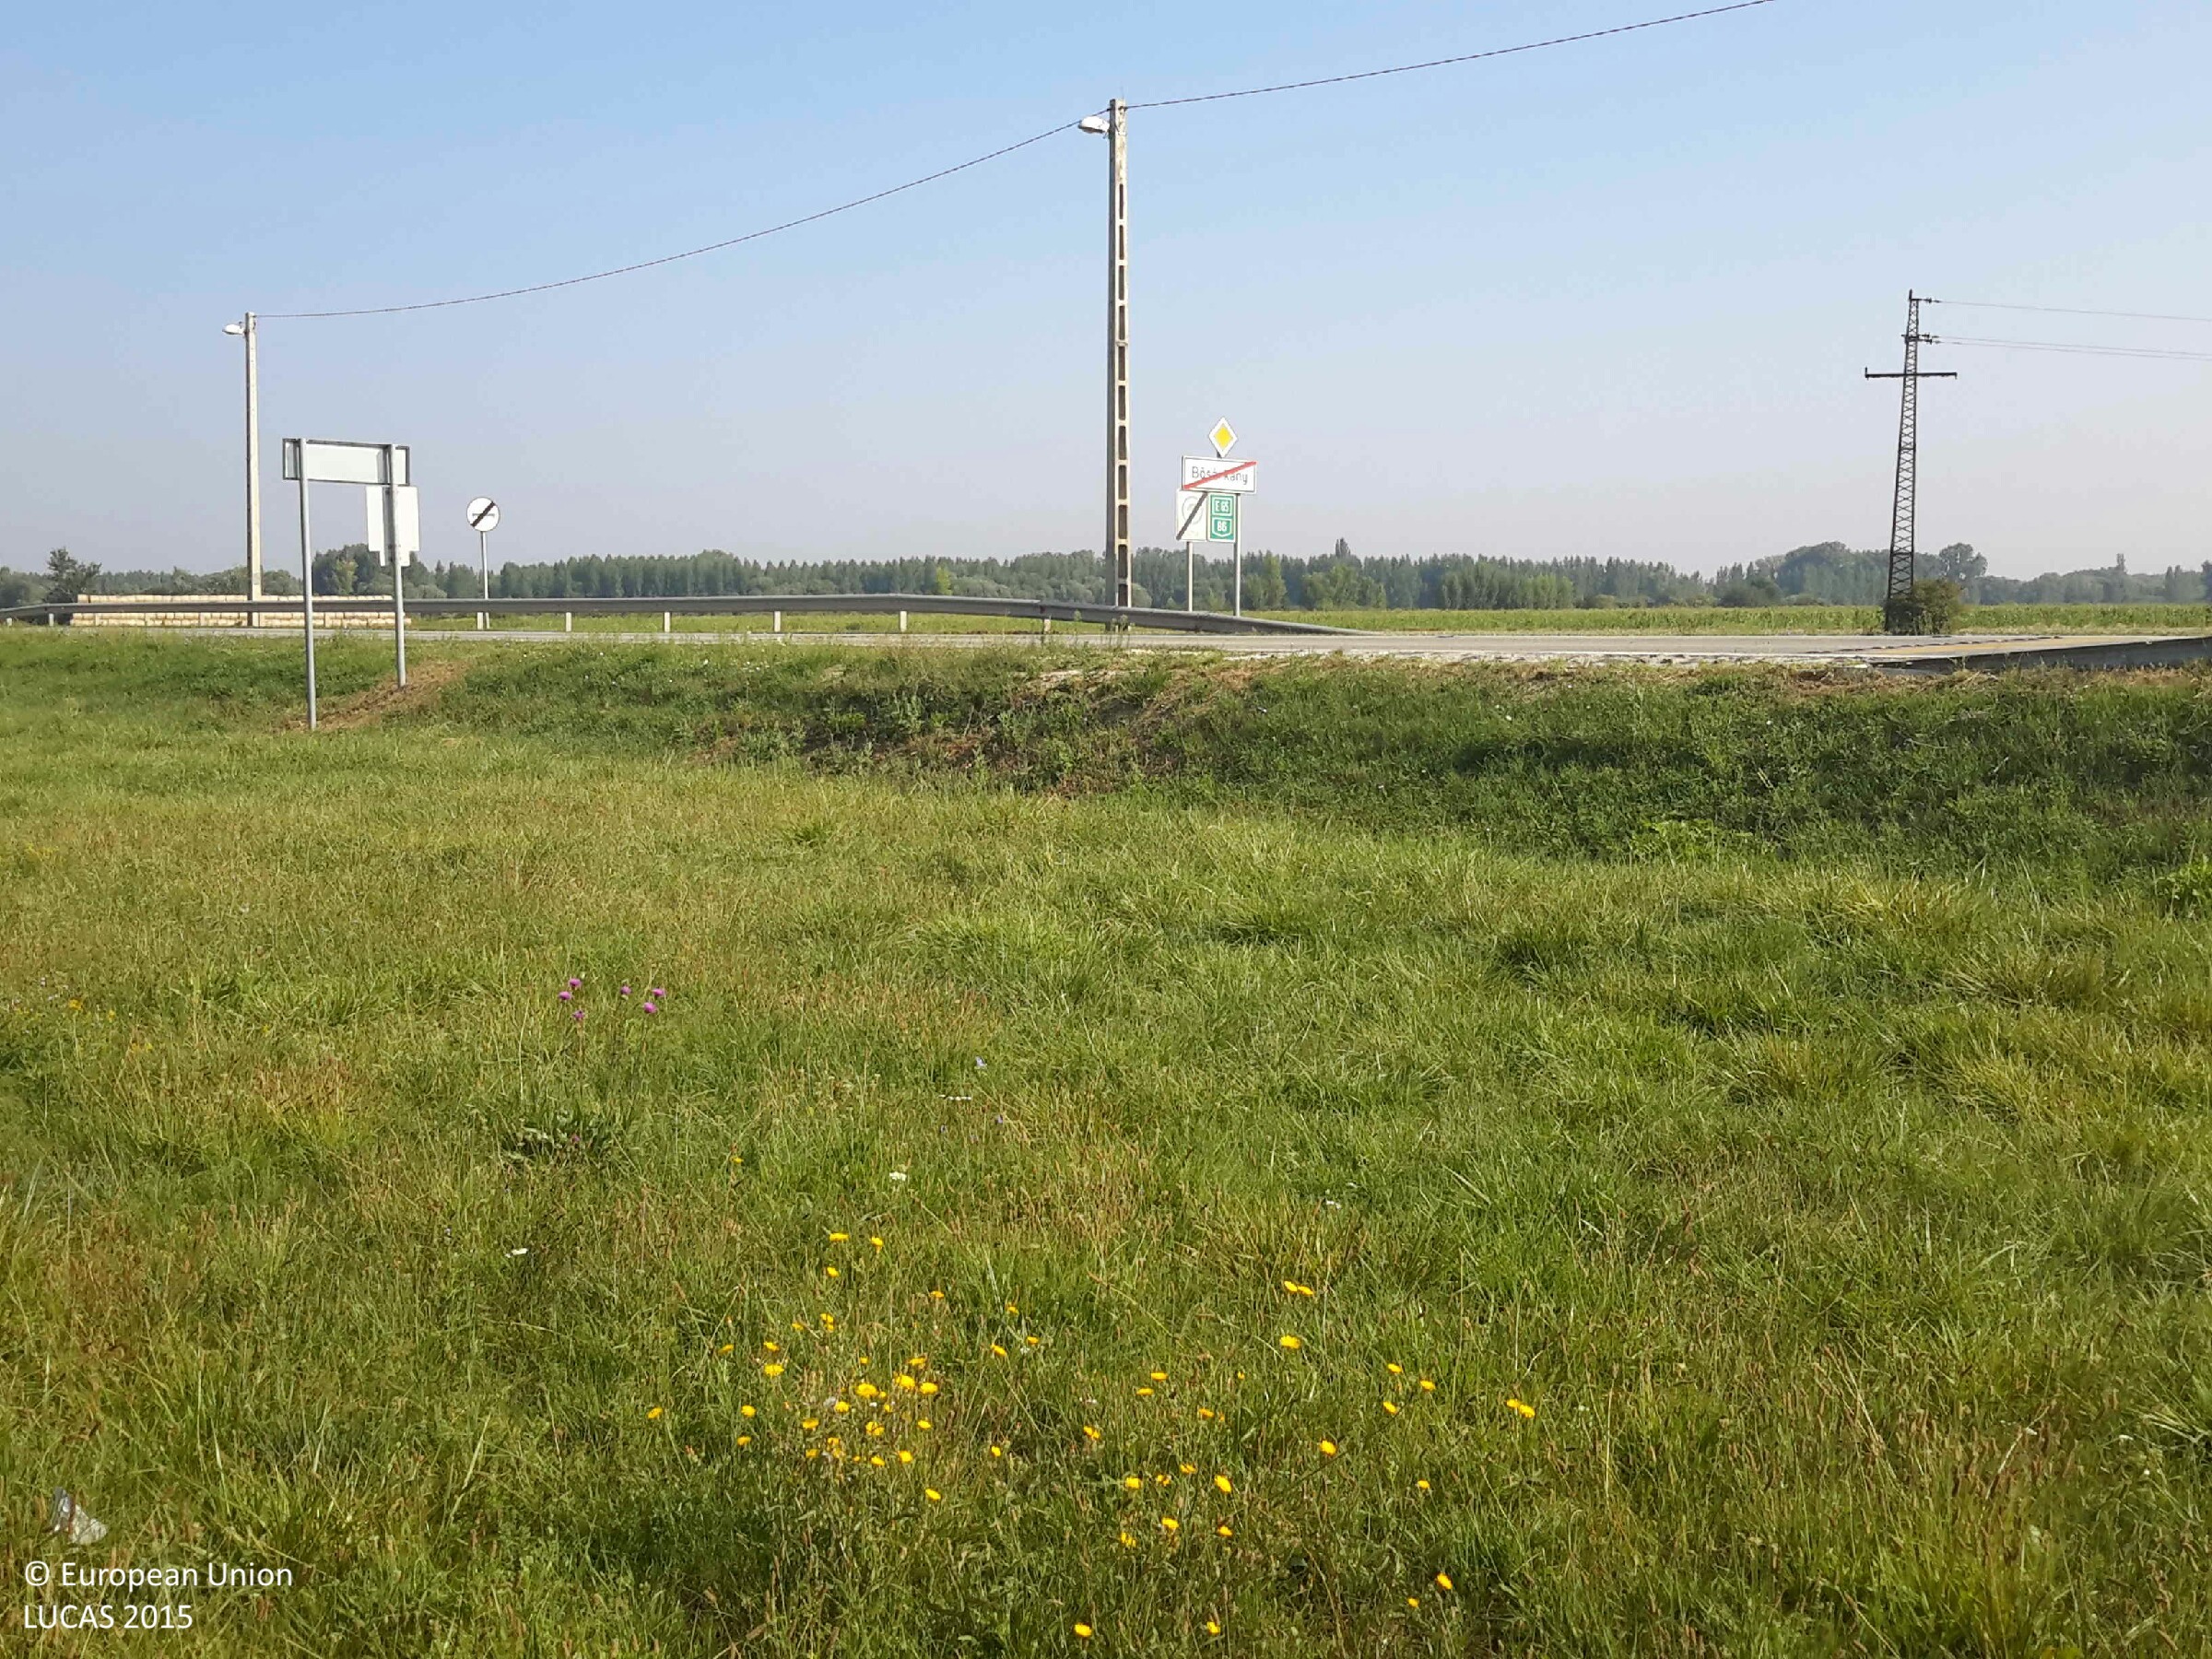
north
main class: Grassland
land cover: Grassland without tree/shrub cover
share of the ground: > 75 %
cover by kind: herbaceous plants 100 %
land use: Agriculture (excluding fallow land and kitchen gardens)
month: August
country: HU
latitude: 47.6961
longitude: 17.2427
